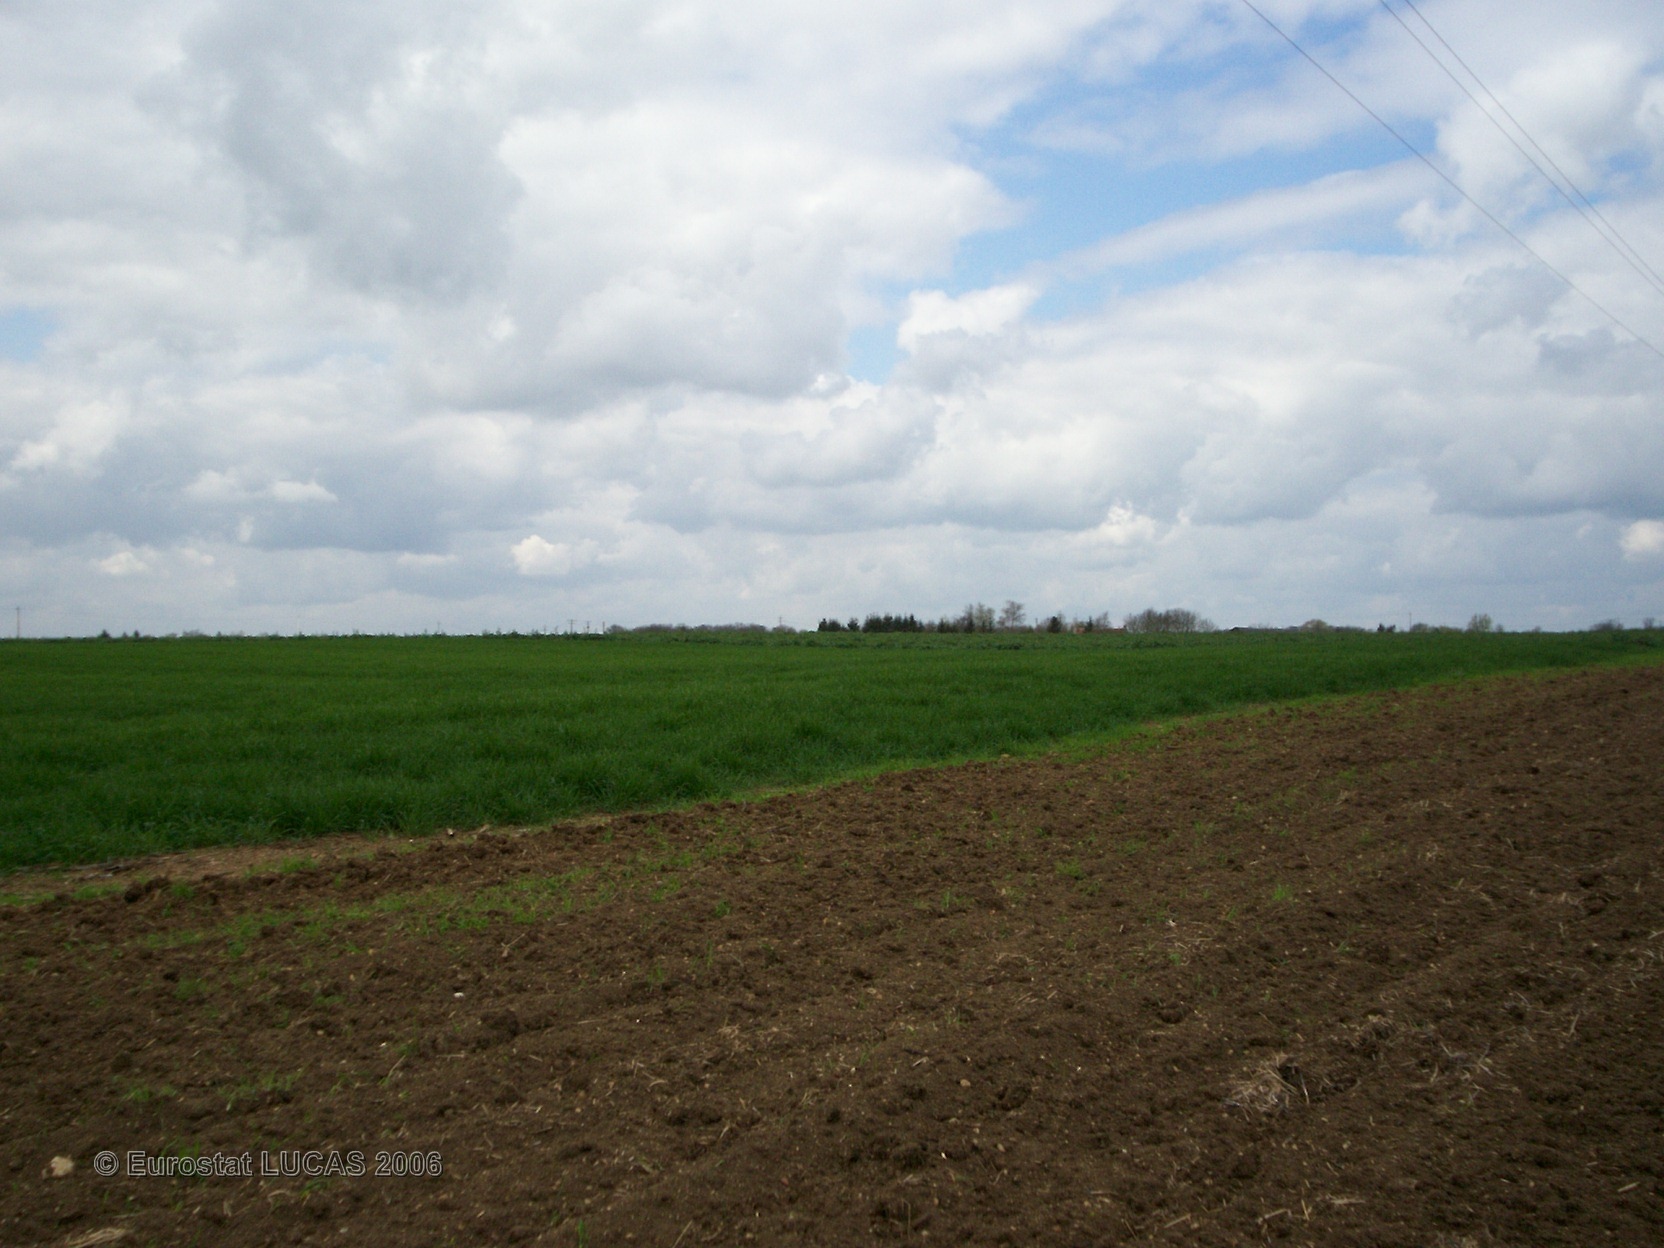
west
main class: Cropland
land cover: Sunflower
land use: Agriculture (excluding fallow land and kitchen gardens)
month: May
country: FR
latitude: 47.5154
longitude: 0.2158
